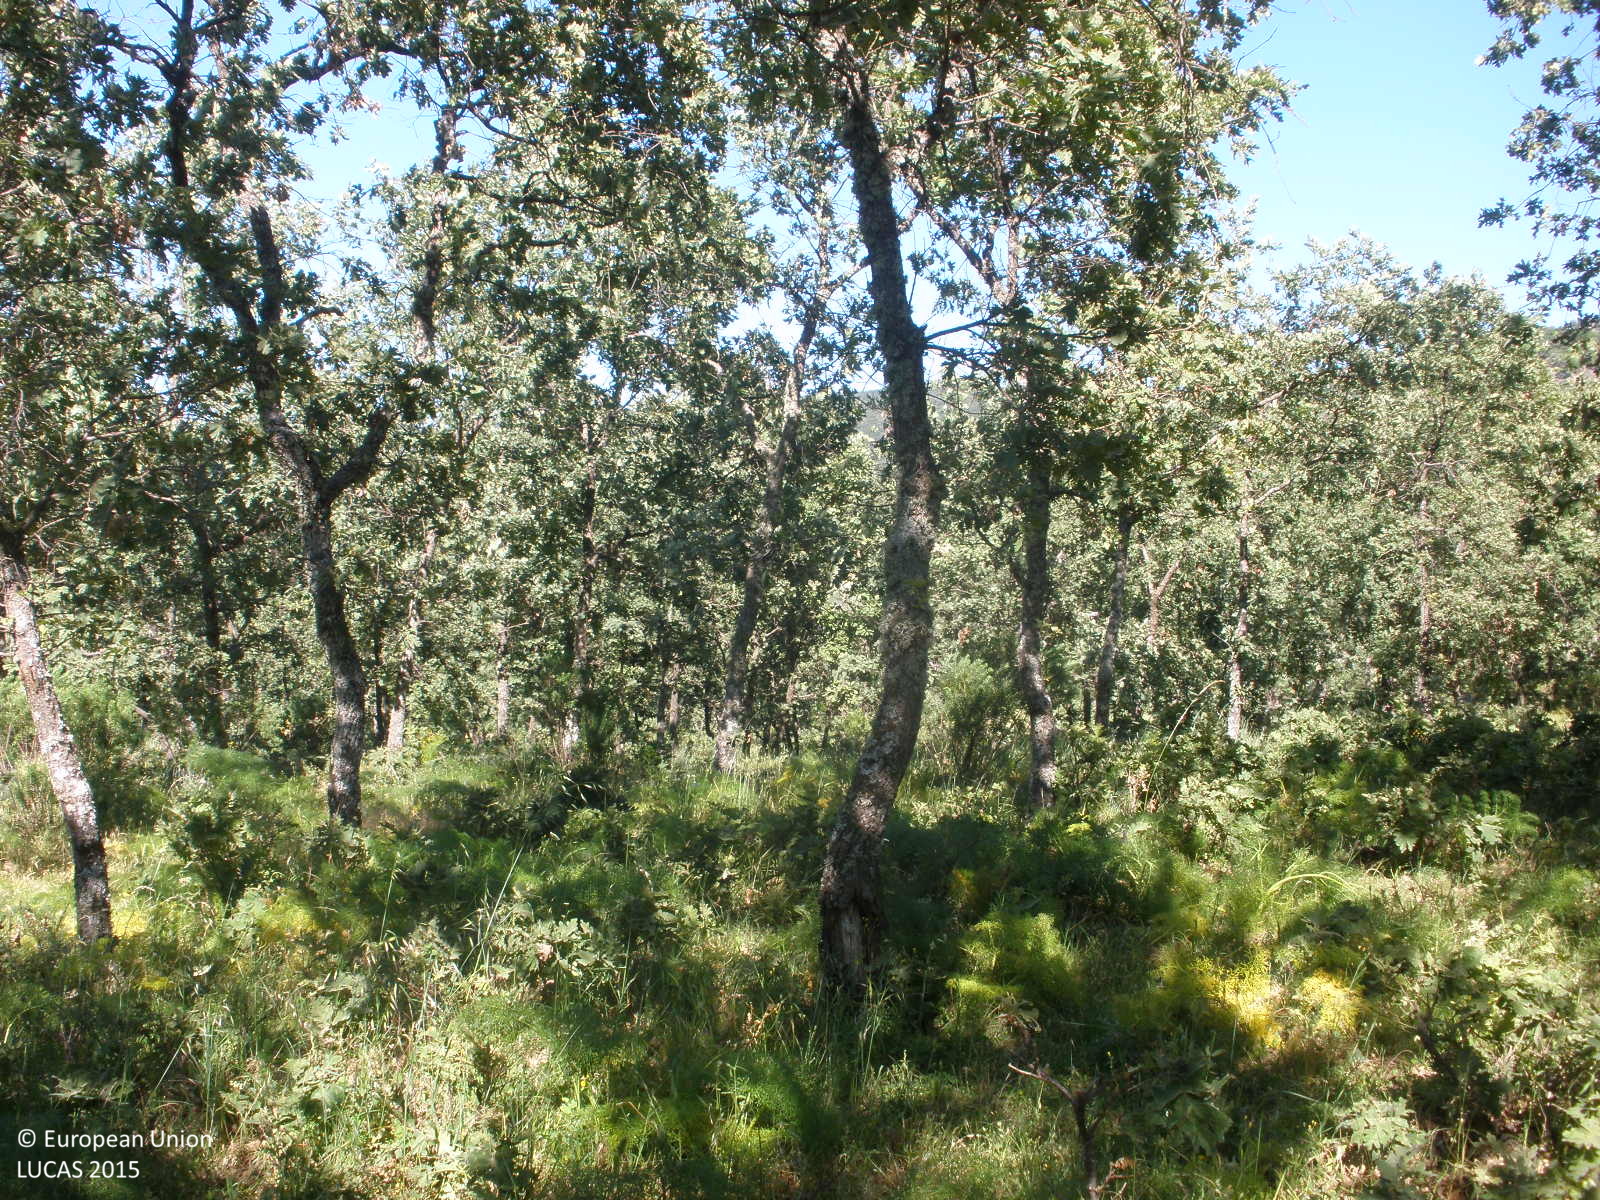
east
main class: Woodland
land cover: Broadleaved woodland
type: broadleaved evergreen forest
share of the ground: > 75 %
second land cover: Grassland without tree/shrub cover
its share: > 75 %
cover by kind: broadleaved forest trees 80 %, herbaceous plants 20 %
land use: Forestry
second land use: Agriculture (excluding fallow land and kitchen gardens)
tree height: > 5 m
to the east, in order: Broadleaved woodland; Grassland without tree/shrub cover; Tracks; Rivers and streams; Fences; Broadleaved woodland; Dry stone walls; Broadleaved woodland; Tracks; Dry stone walls; Grassland without tree/shrub cover
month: May
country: ES
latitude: 40.1358
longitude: -6.7891
